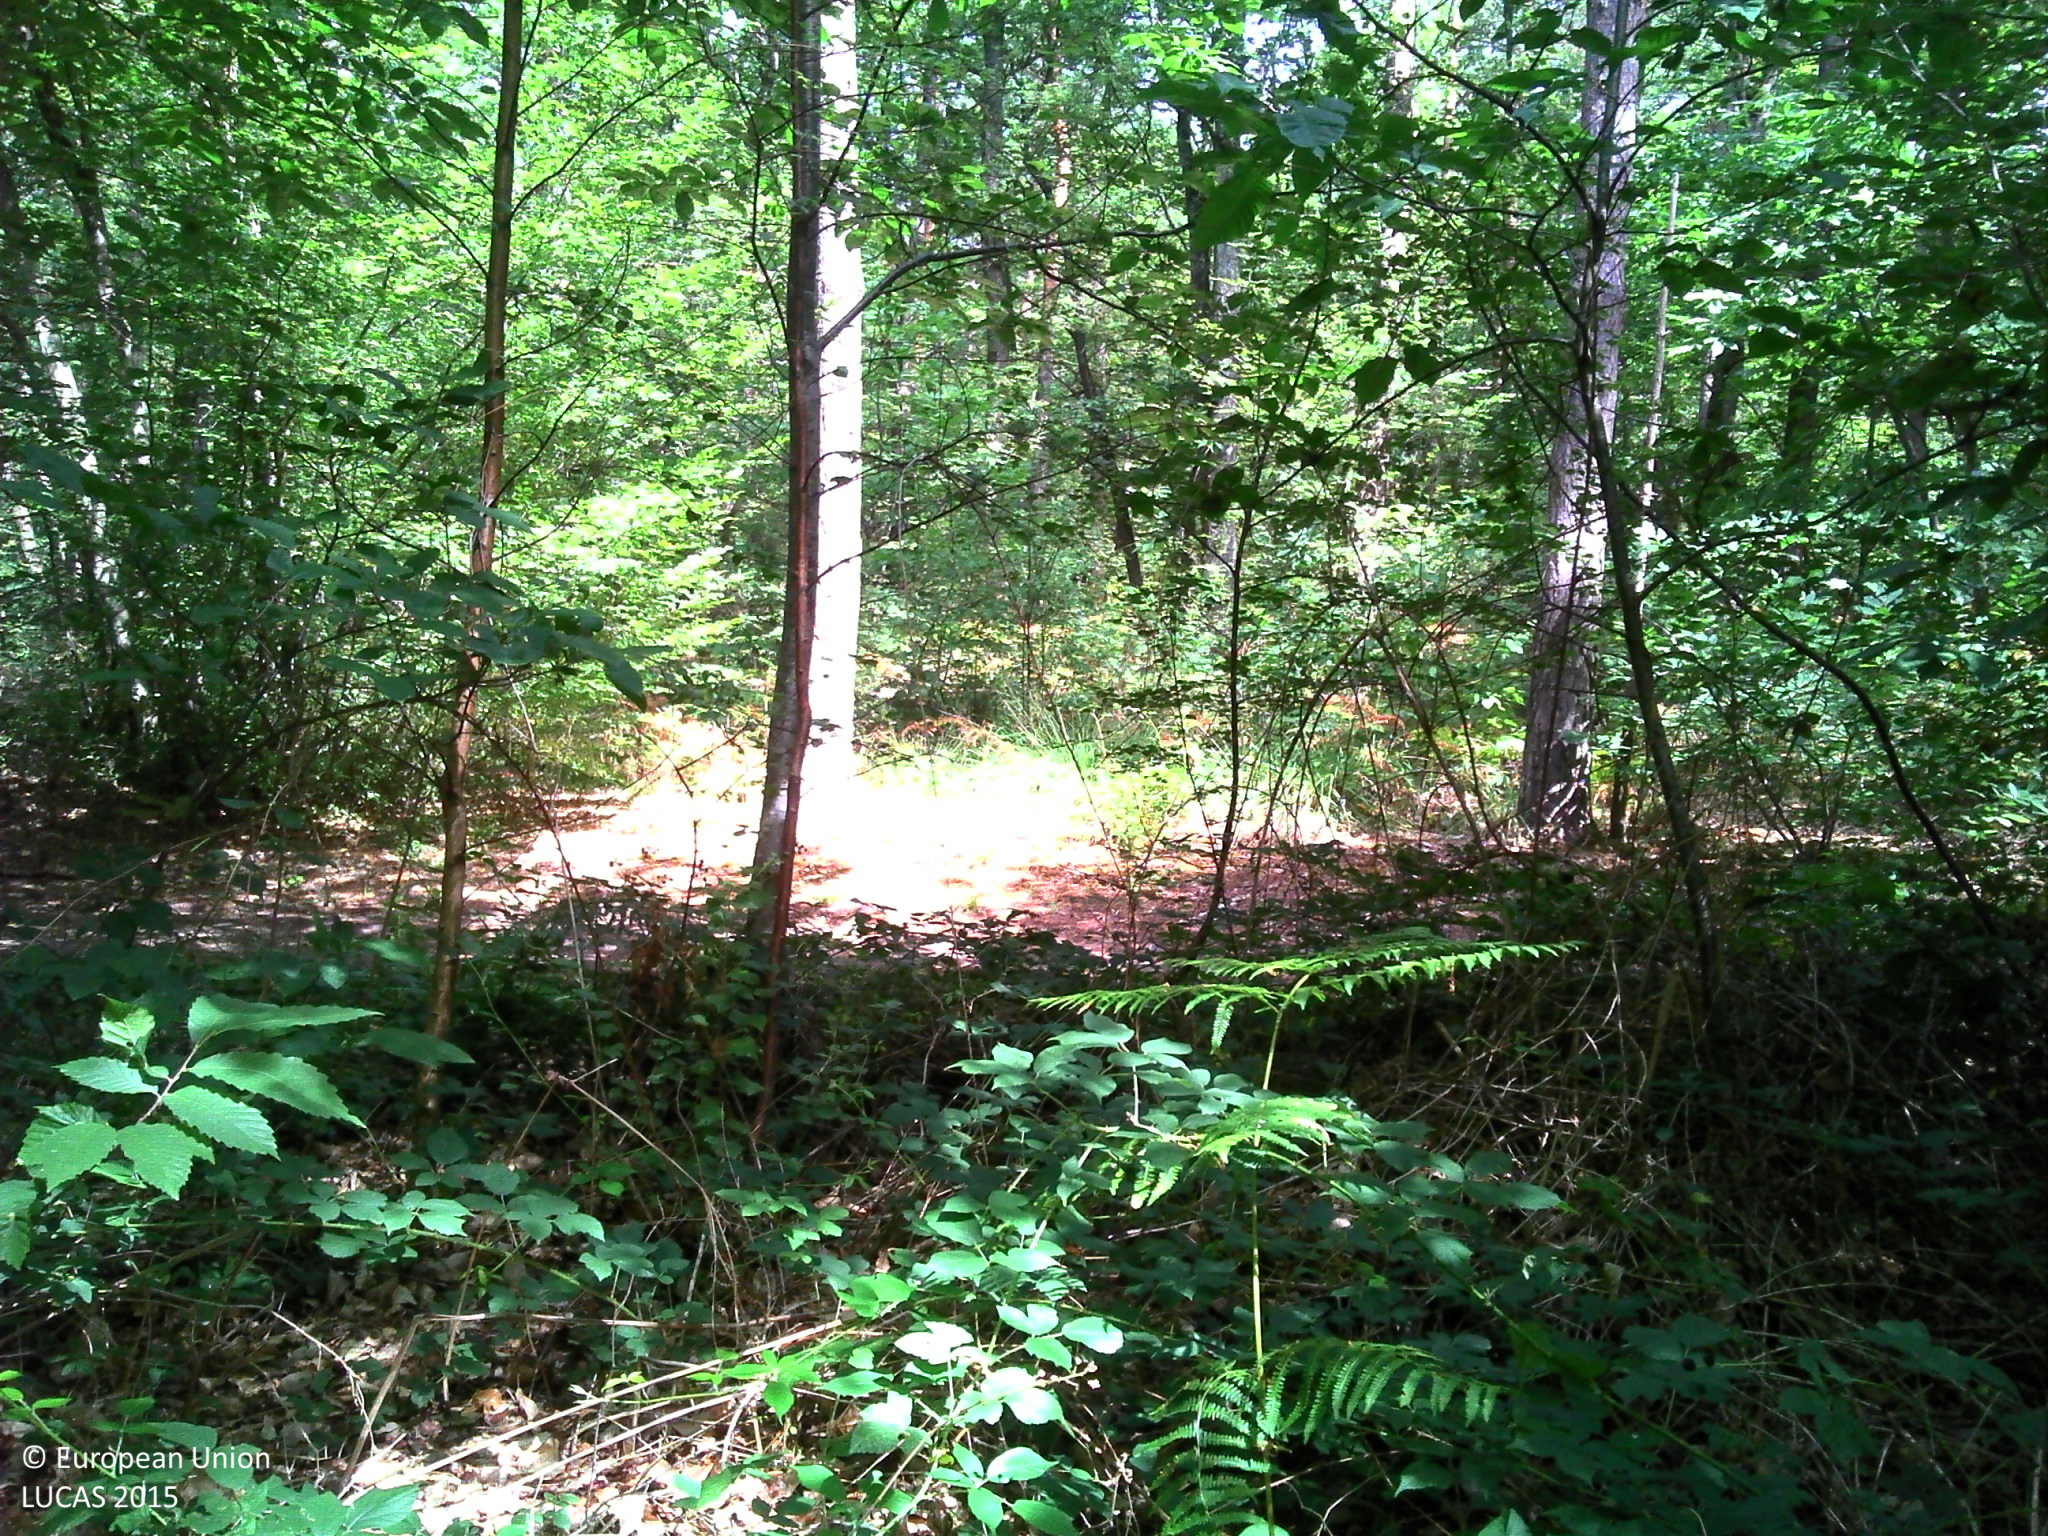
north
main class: Woodland
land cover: Broadleaved woodland
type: thermophilous deciduous forest
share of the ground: > 75 %
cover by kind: shrubs 40 %, broadleaved forest trees 30 %, unconsolidated bare surface 30 %
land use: Forestry
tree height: > 5 m
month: August
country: FR
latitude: 48.3994
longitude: 2.7375
